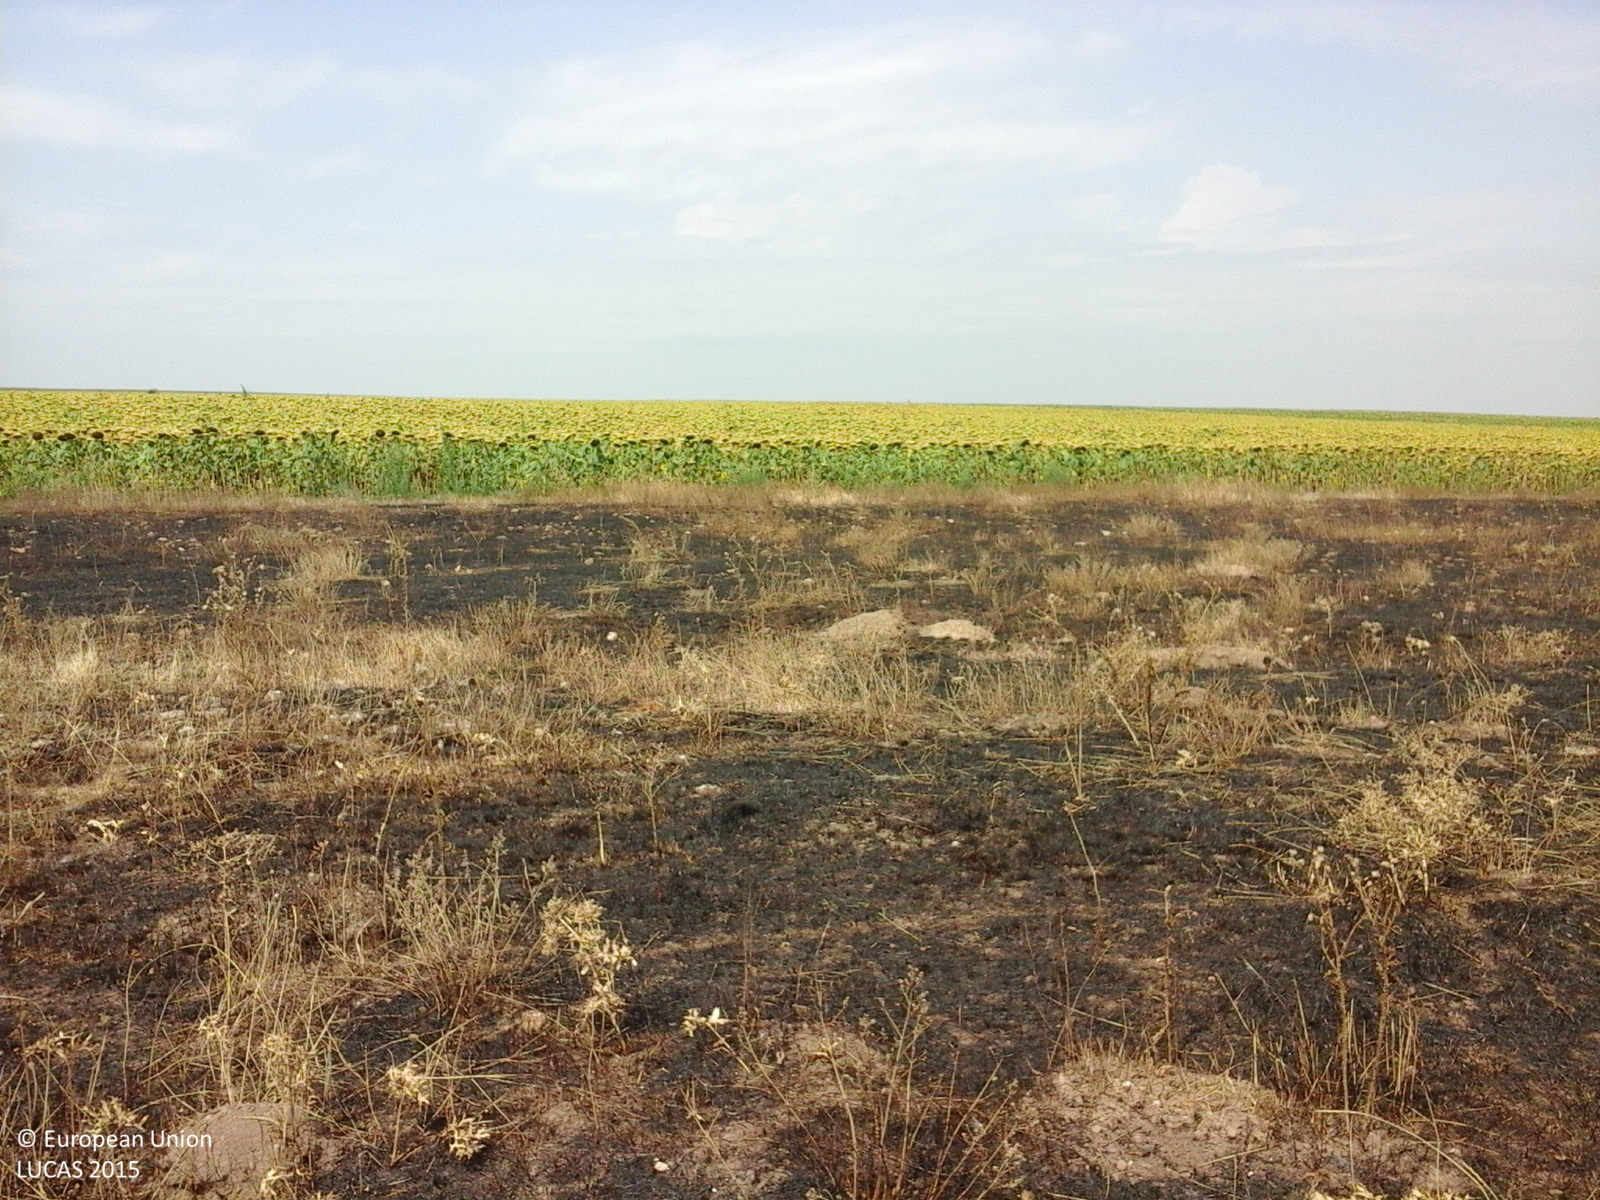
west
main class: Grassland
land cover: Spontaneously vegetated surfaces
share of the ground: > 75 %
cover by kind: herbaceous plants 70 %, consolidated bare surface 30 %
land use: Fallow land
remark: Burnt area
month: August
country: RO
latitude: 43.7660
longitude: 28.3585
